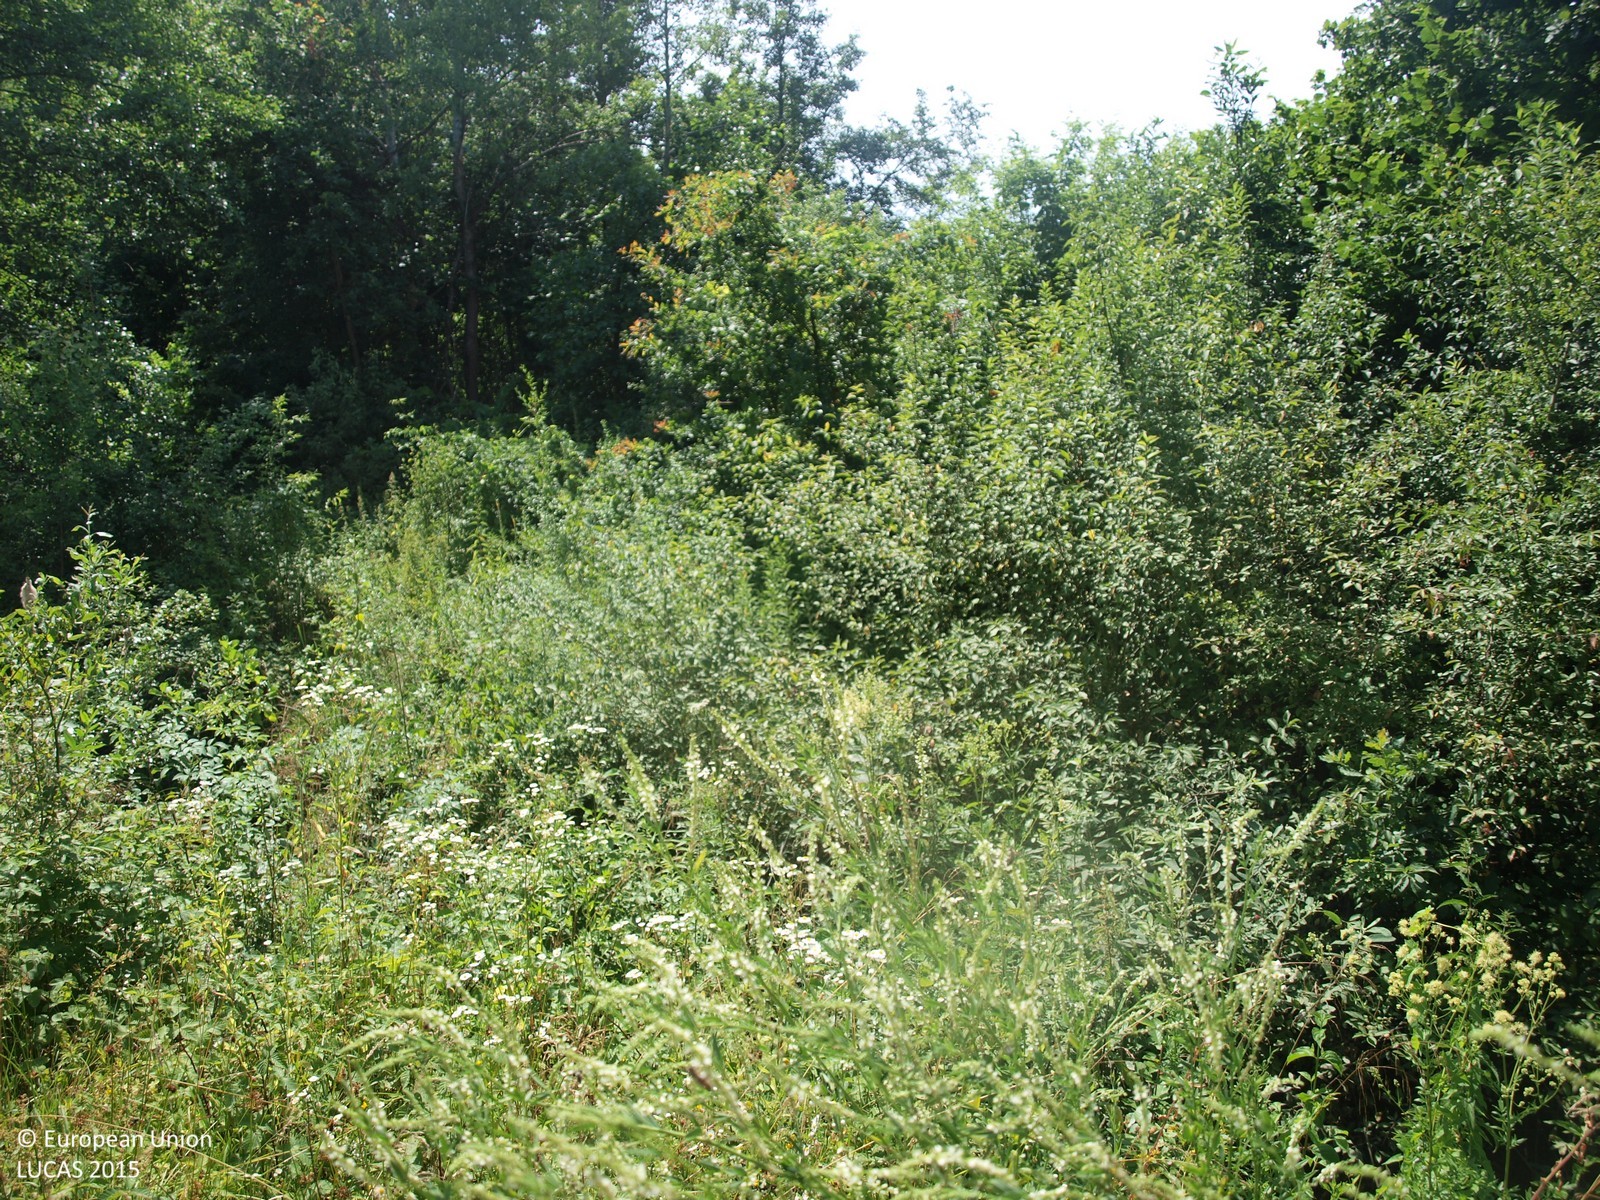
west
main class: Woodland
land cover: Broadleaved woodland
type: floodplain forest
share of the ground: > 75 %
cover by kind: broadleaved forest trees 100 %
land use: Forestry
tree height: > 5 m
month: July
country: HR
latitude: 45.6377
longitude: 15.7315
